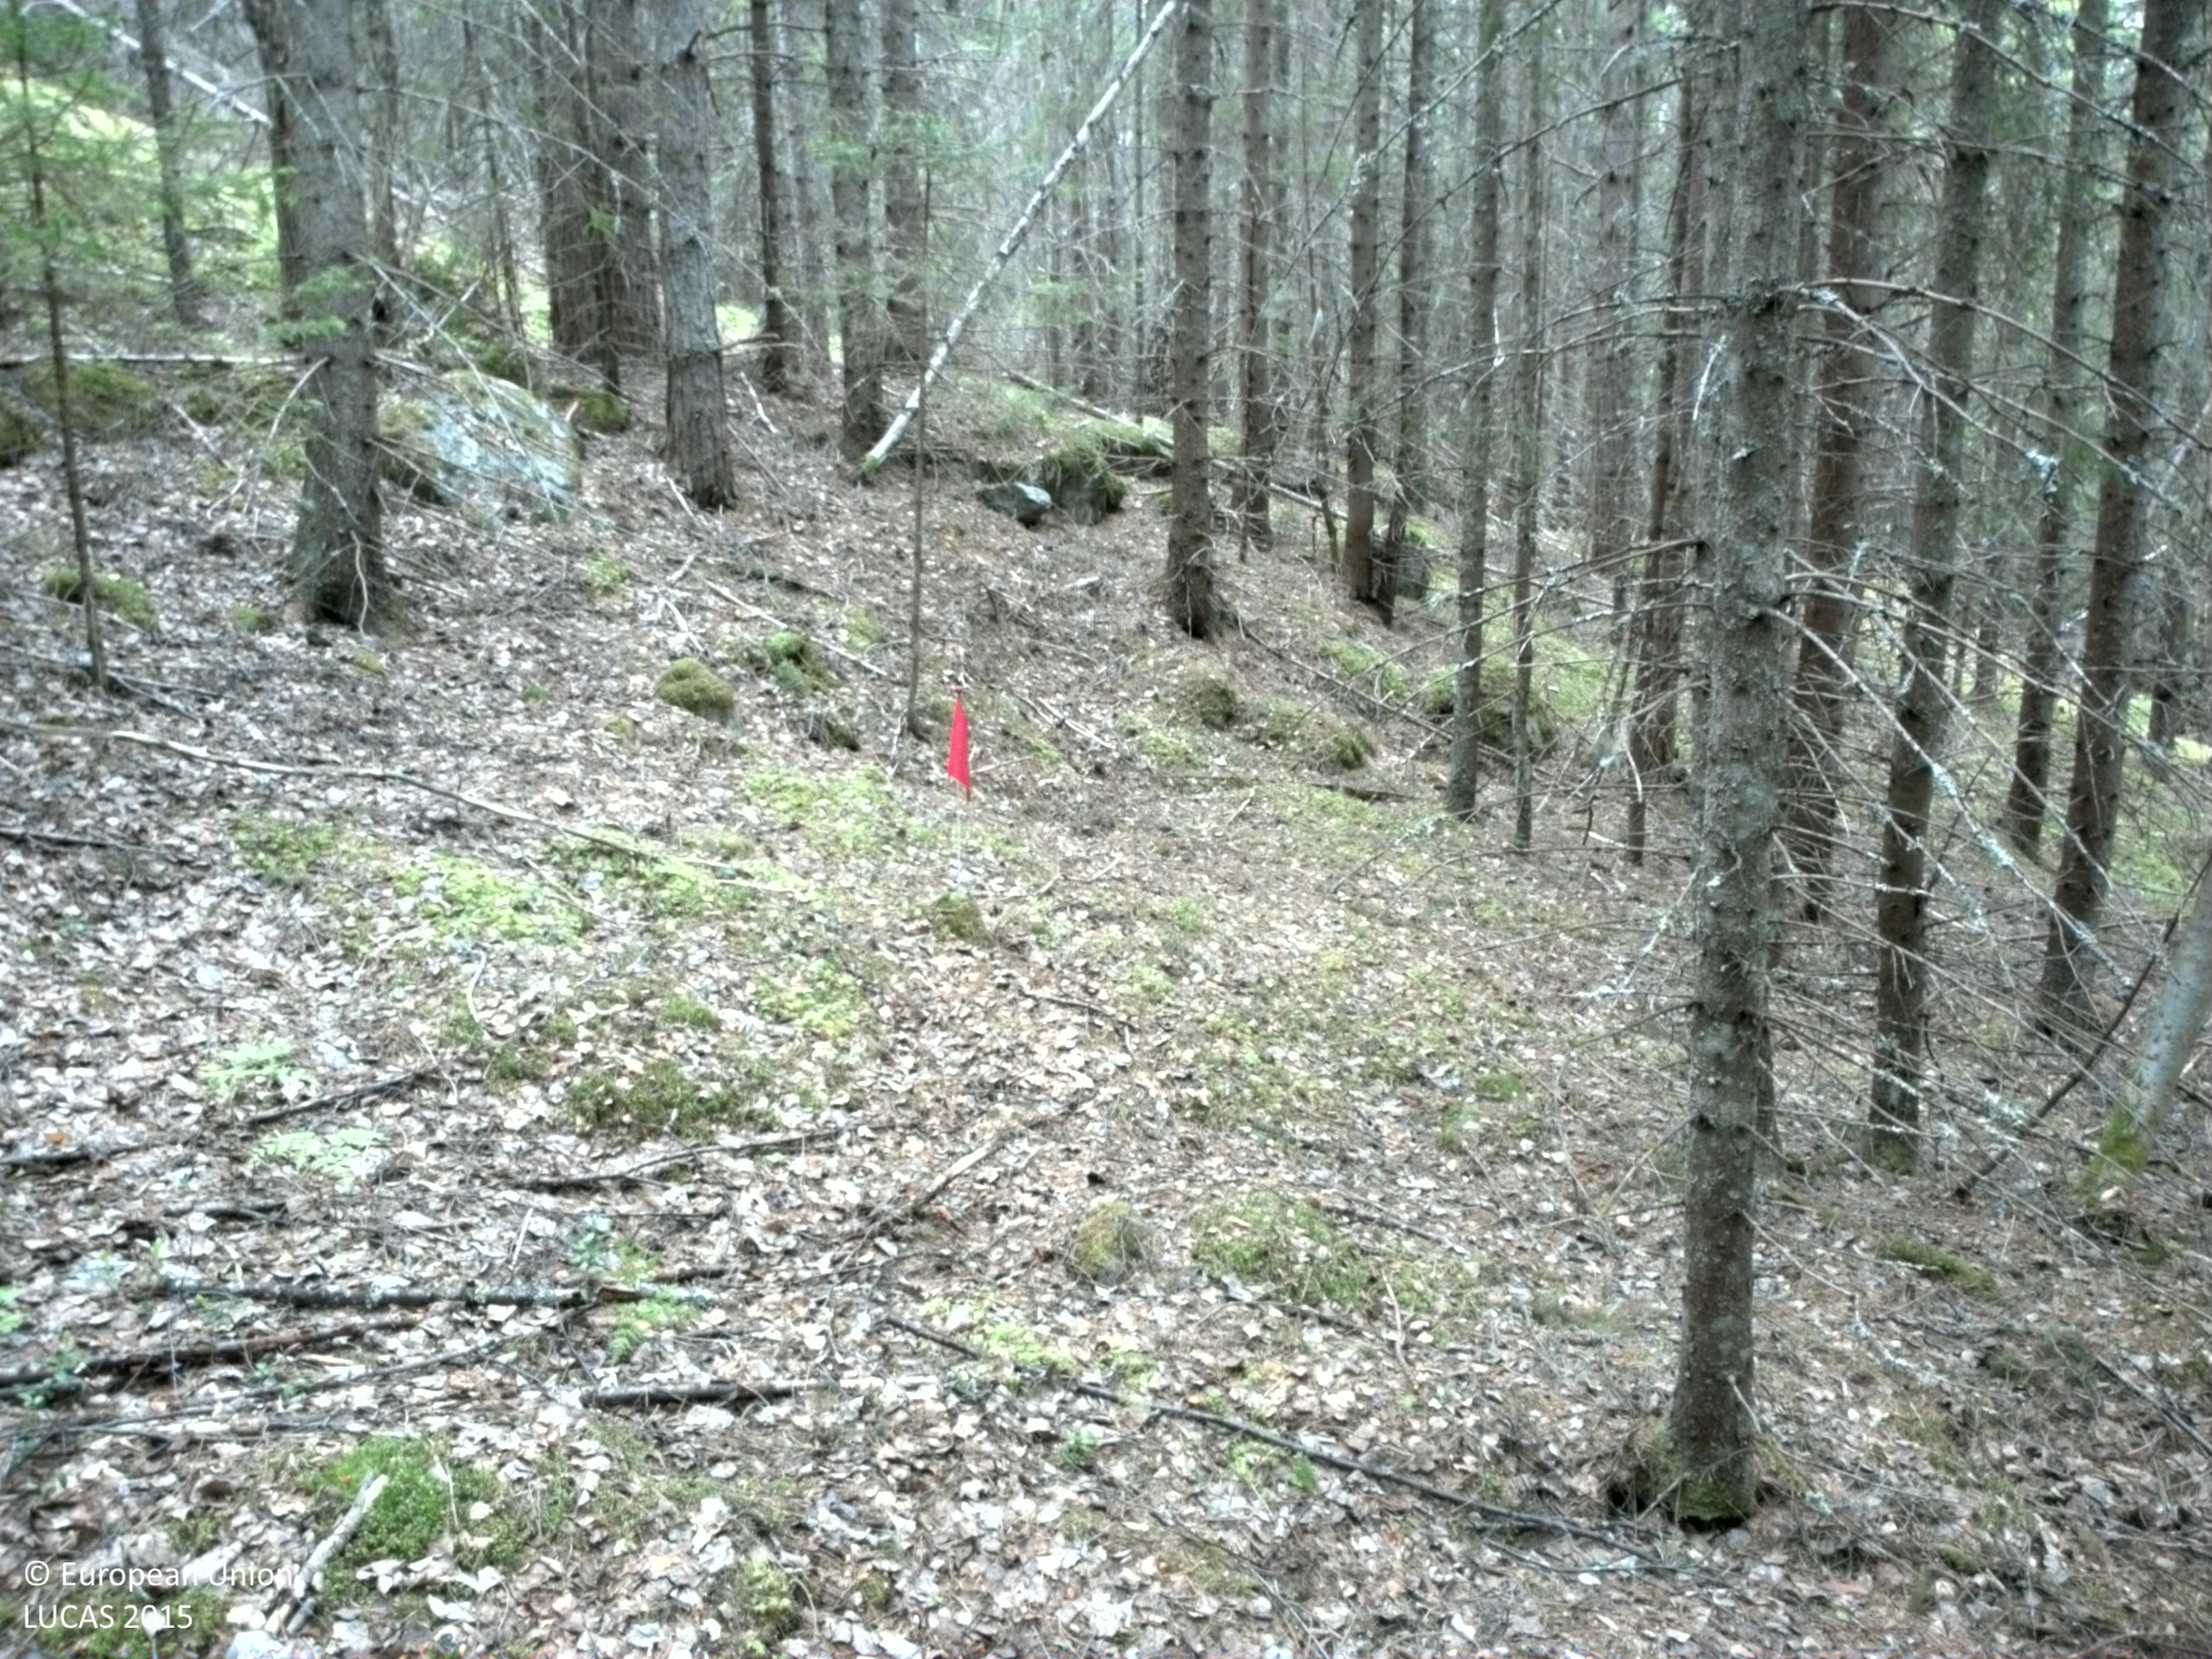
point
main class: Woodland
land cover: Spruce dominated coniferous woodland
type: boreal forest
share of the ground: > 75 %
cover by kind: coniferous forest trees 80 %, herbaceous plants 10 %, broadleaved forest trees 5 %, unconsolidated bare surface 5 %
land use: Forestry
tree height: > 5 m
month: June
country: SE
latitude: 62.9519
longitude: 17.8428
